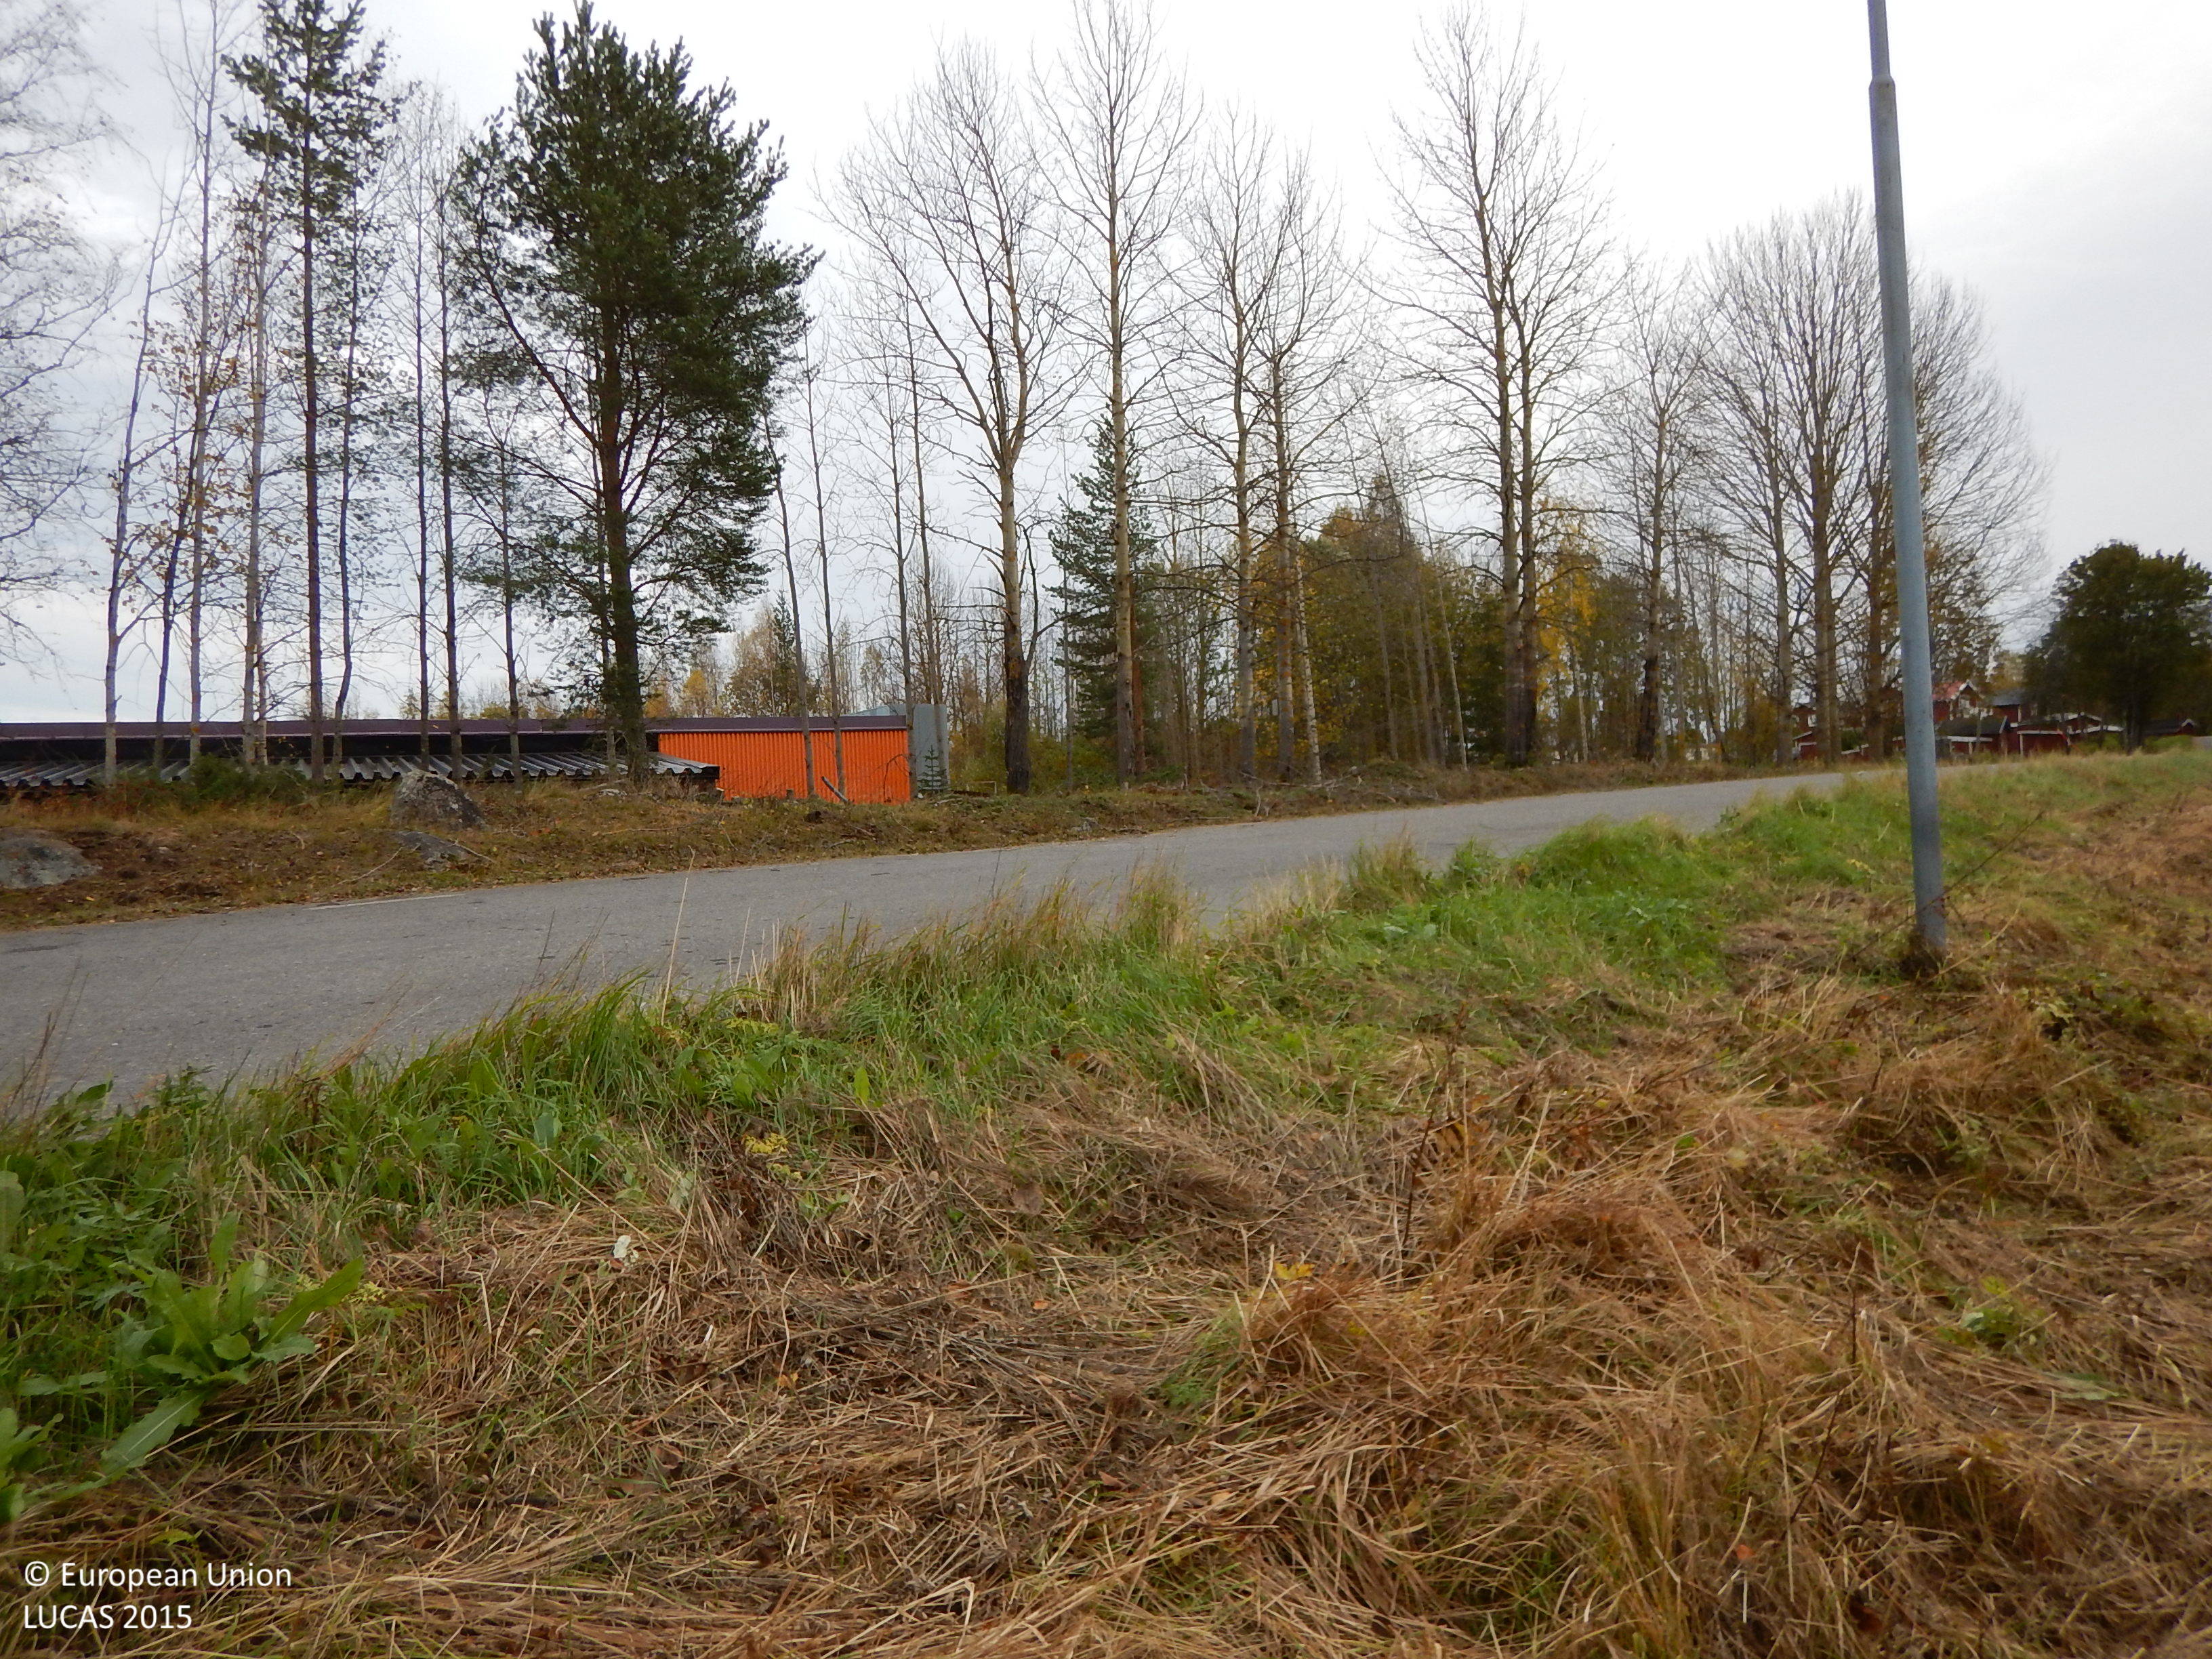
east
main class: Grassland
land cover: Grassland without tree/shrub cover
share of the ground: > 75 %
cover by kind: herbaceous plants 100 %
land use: Agriculture (excluding fallow land and kitchen gardens)
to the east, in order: Grassland without tree/shrub cover; Ditches and canals; Grassland without tree/shrub cover; Fences; Grassland without tree/shrub cover; Ditches and canals; Grassland without tree/shrub cover; Paved roads, cycling and walking lanes; Ditches and canals; Other mixed woodland; Artificial constructions in urban areas; Ditches and canals; Other mixed woodland; Fences; Grassland without tree/shrub cover
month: October
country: SE
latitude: 64.8455
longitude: 20.8773
